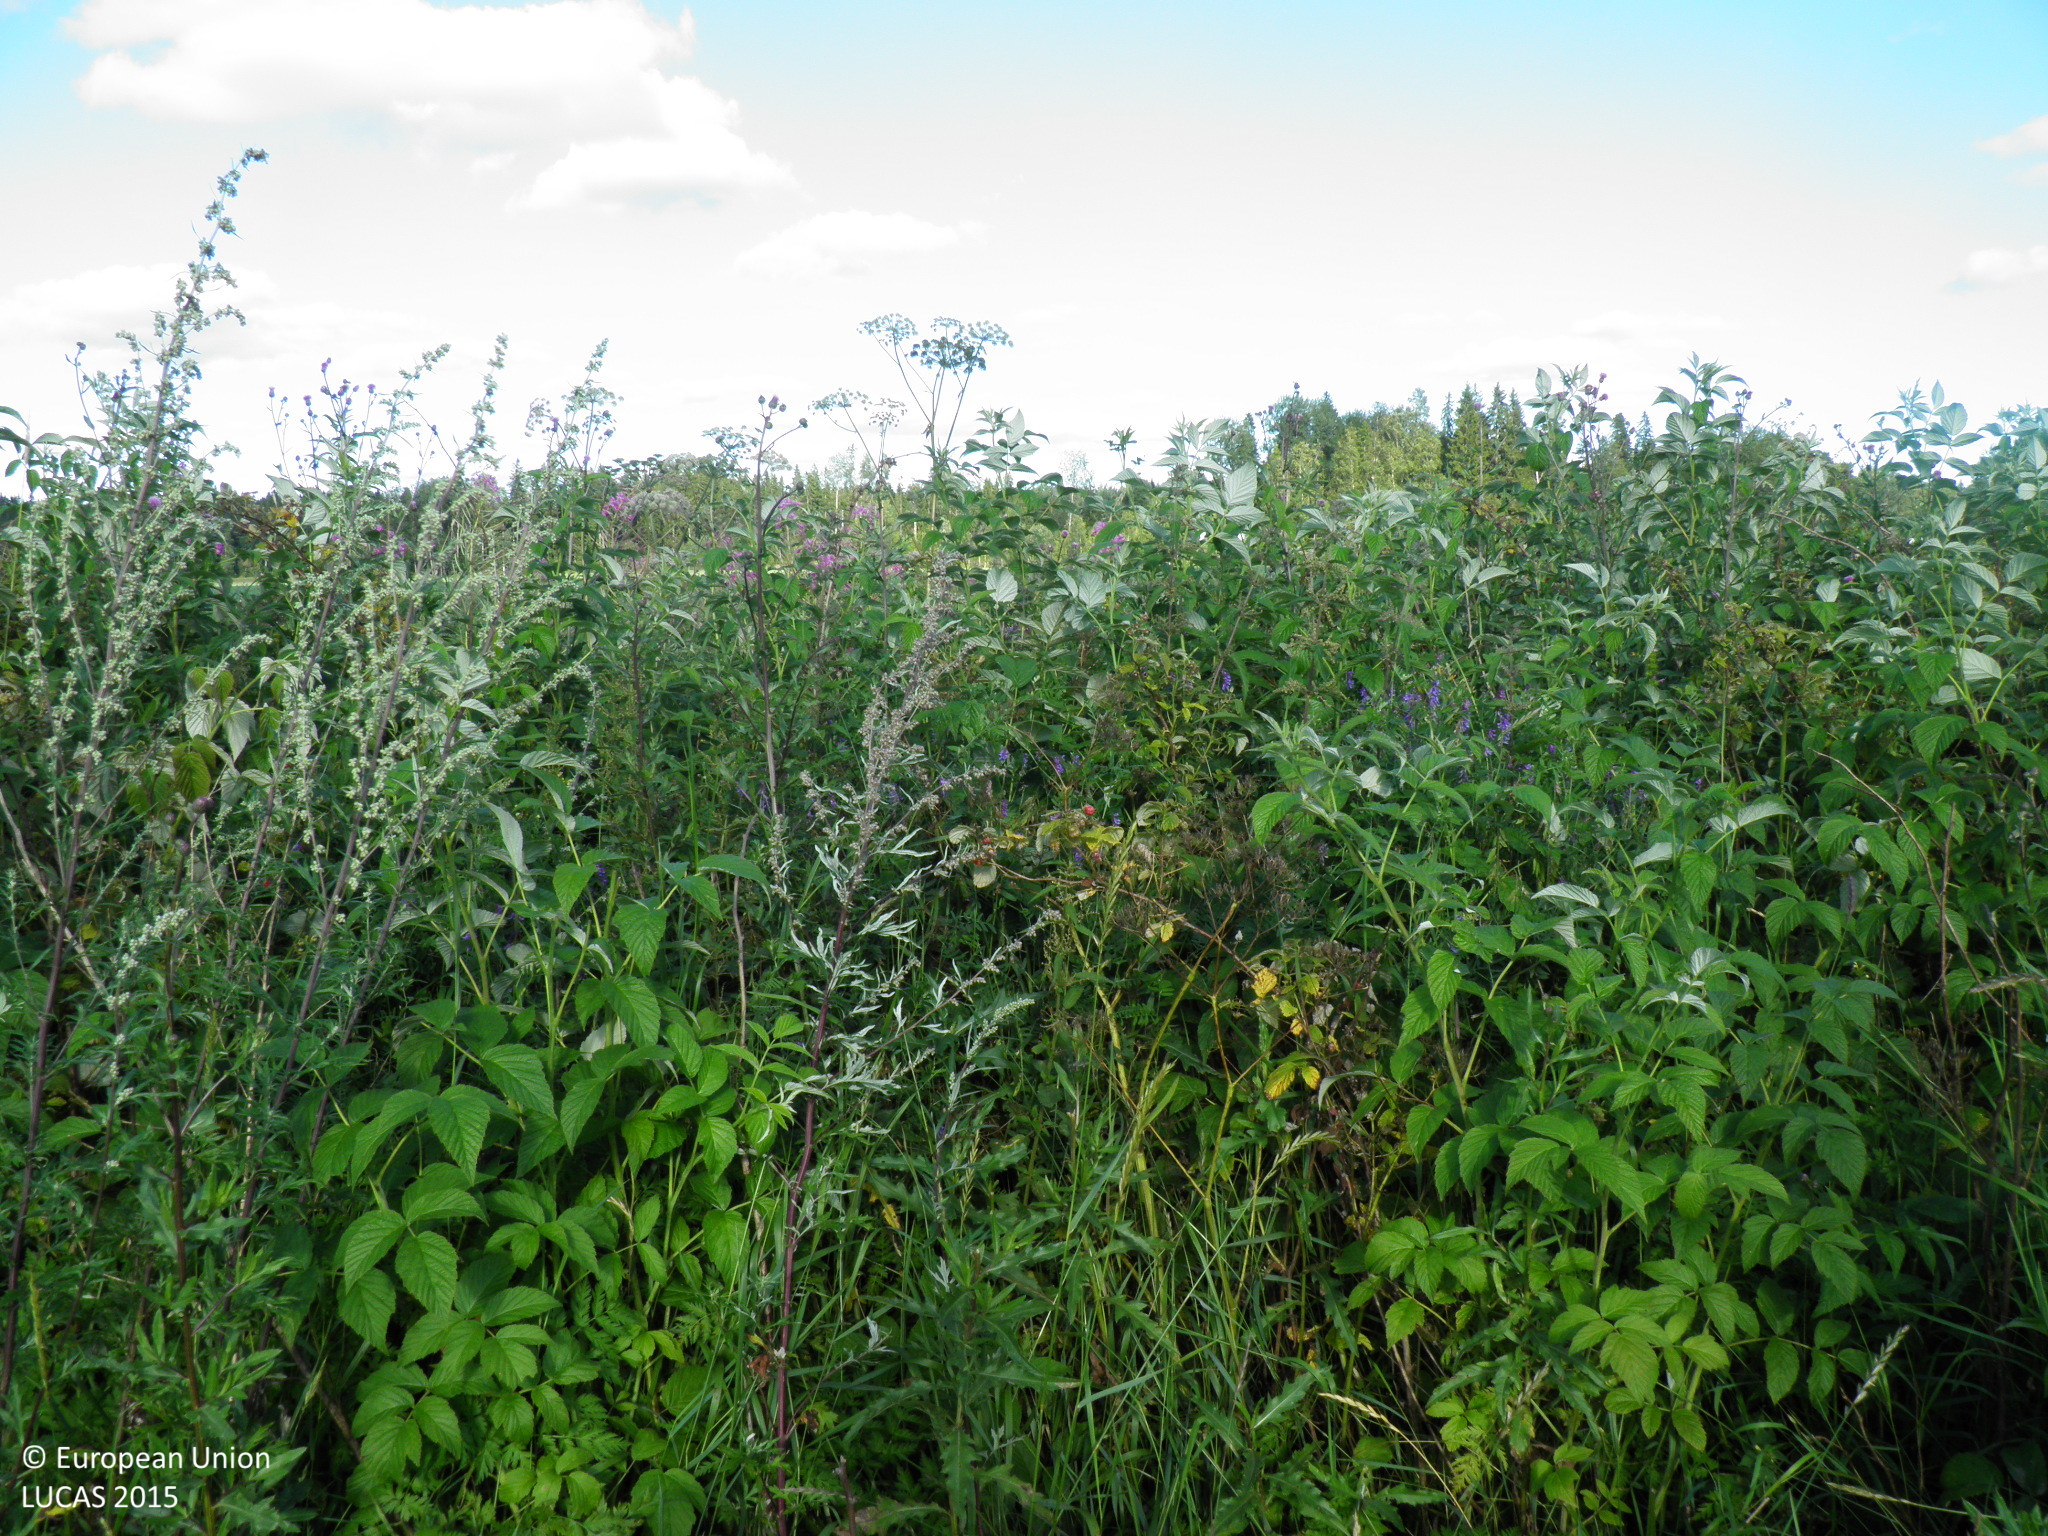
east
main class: Cropland
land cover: Common wheat
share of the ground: > 75 %
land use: Agriculture (excluding fallow land and kitchen gardens)
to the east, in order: Common wheat; Abandoned hedges; Inland fresh running water; Abandoned hedges; Oats
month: August
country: FI
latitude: 61.0022
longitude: 23.0006
